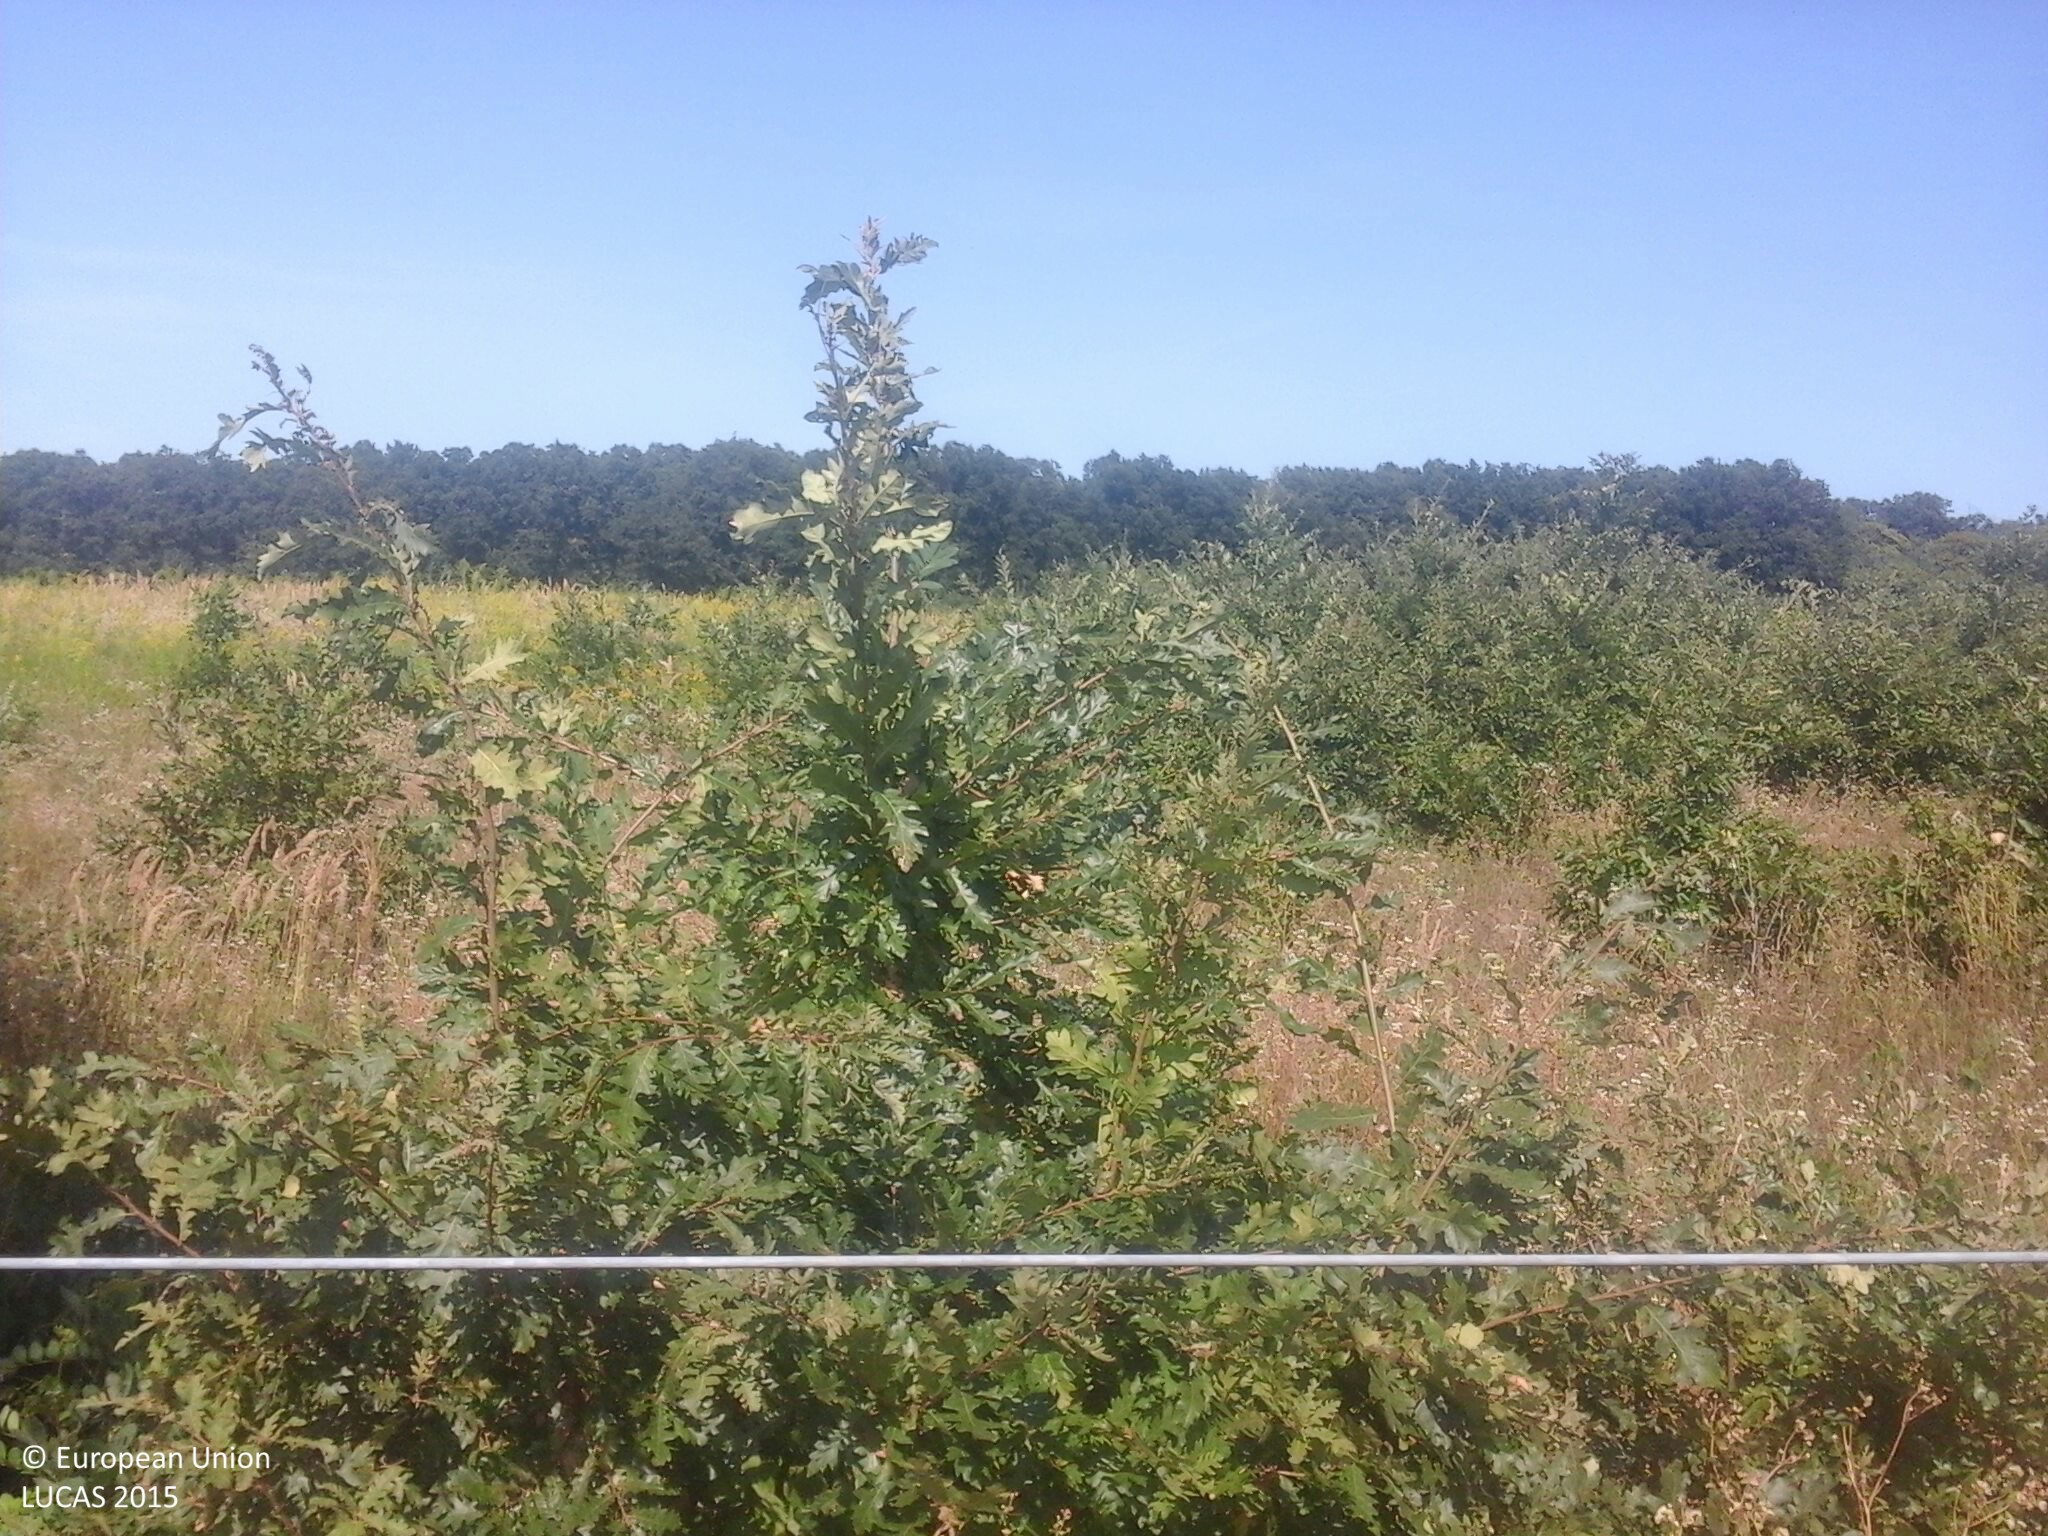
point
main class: Woodland
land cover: Broadleaved woodland
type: mesophytic deciduous forest
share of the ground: > 75 %
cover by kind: broadleaved forest trees 80 %, herbaceous plants 20 %
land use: Forestry
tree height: < 5 m
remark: Nursery
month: August
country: HU
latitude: 46.8535
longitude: 17.9168
